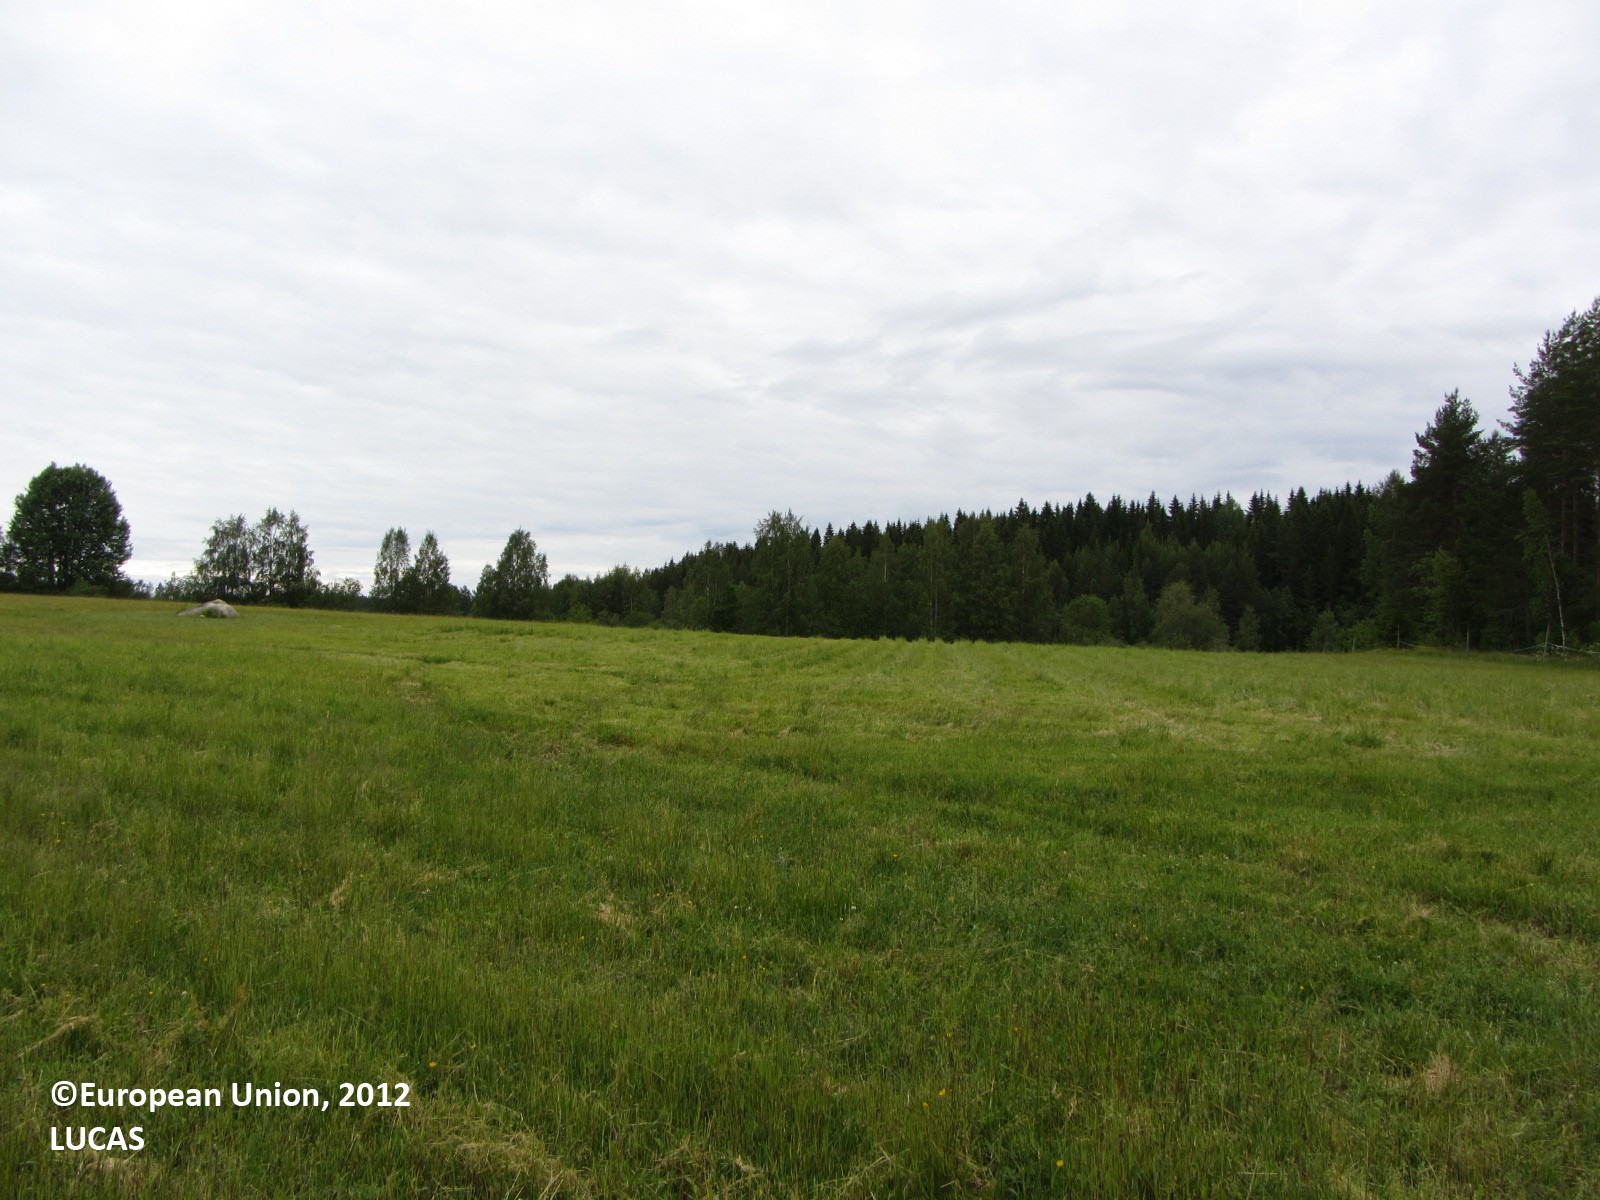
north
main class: Grassland
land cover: Grassland without tree/shrub cover
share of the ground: > 75 %
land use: Agriculture (excluding fallow land and kitchen gardens)
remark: Harvested field
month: June
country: FI
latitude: 62.6565
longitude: 25.2678
